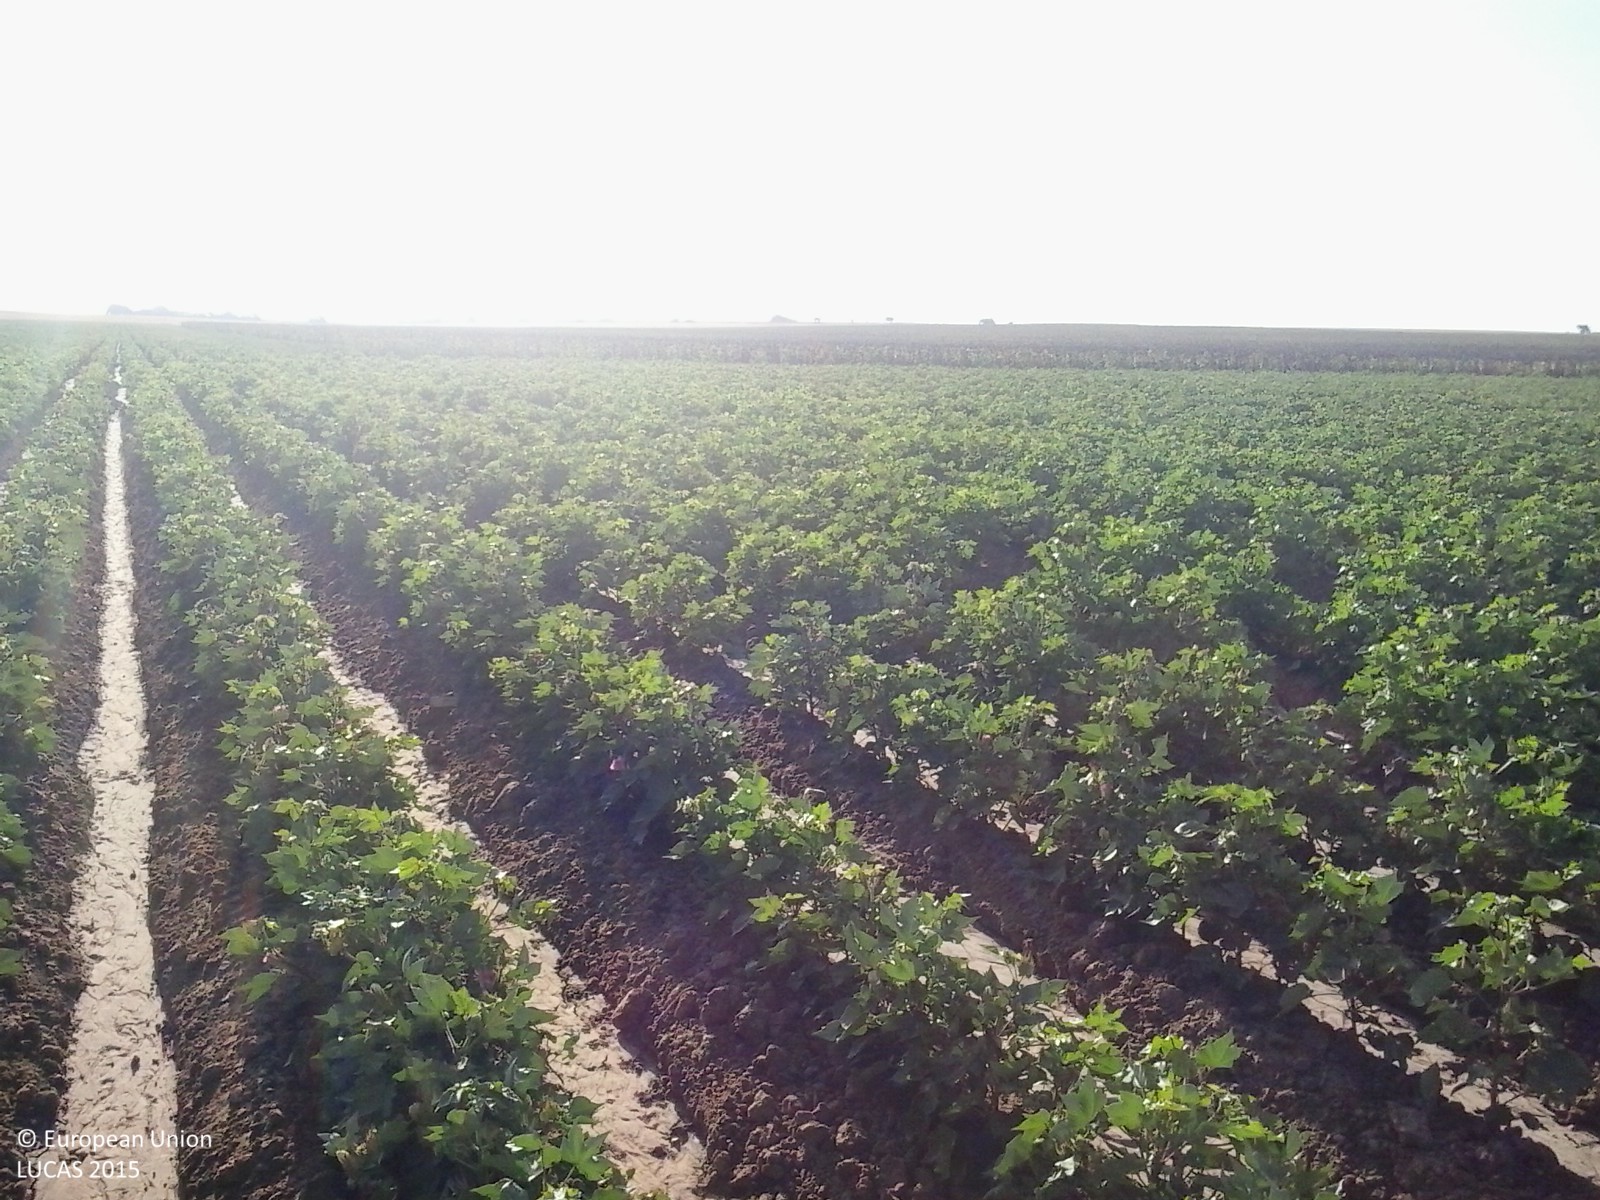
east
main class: Cropland
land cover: Cotton
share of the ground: 25 - 50 %
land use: Agriculture (excluding fallow land and kitchen gardens)
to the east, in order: Cotton; Sunflower
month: July
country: ES
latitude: 37.0958
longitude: -5.8232
